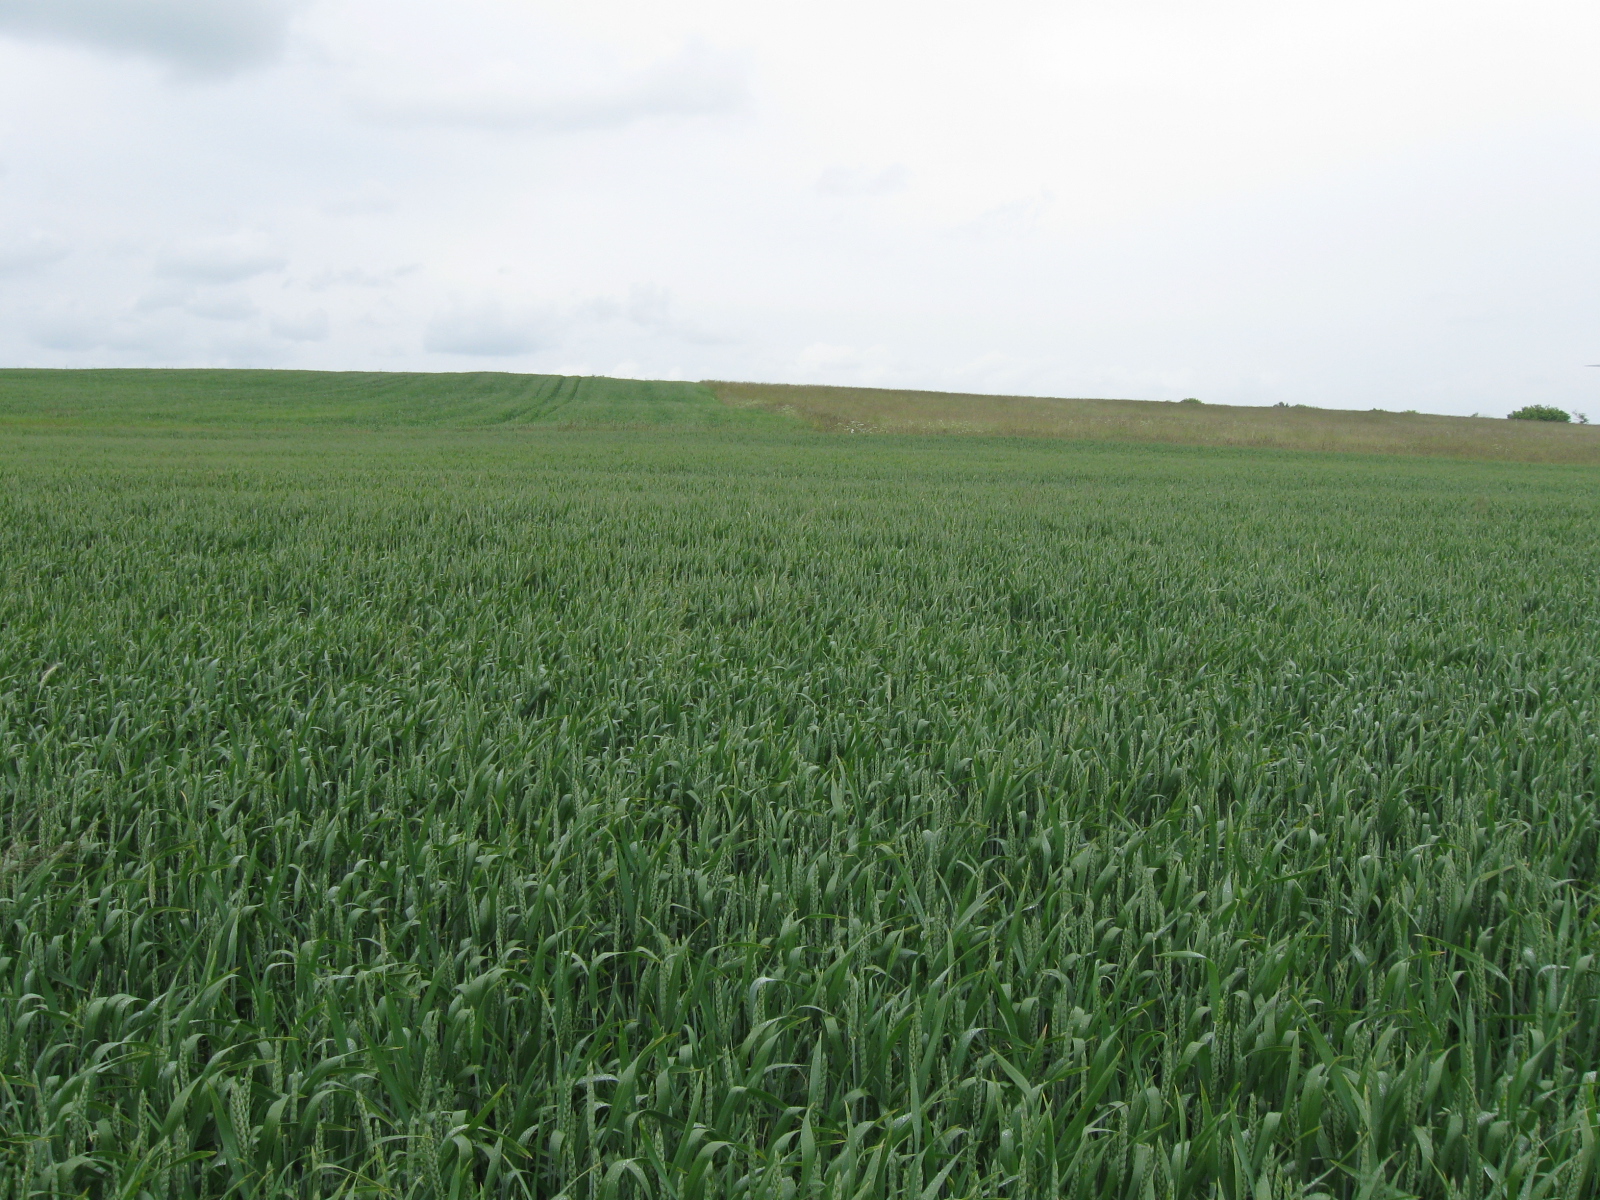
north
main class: Cropland
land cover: Common wheat
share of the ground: > 75 %
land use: Agriculture (excluding fallow land and kitchen gardens)
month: June
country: LT
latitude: 54.9113
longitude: 24.5633
